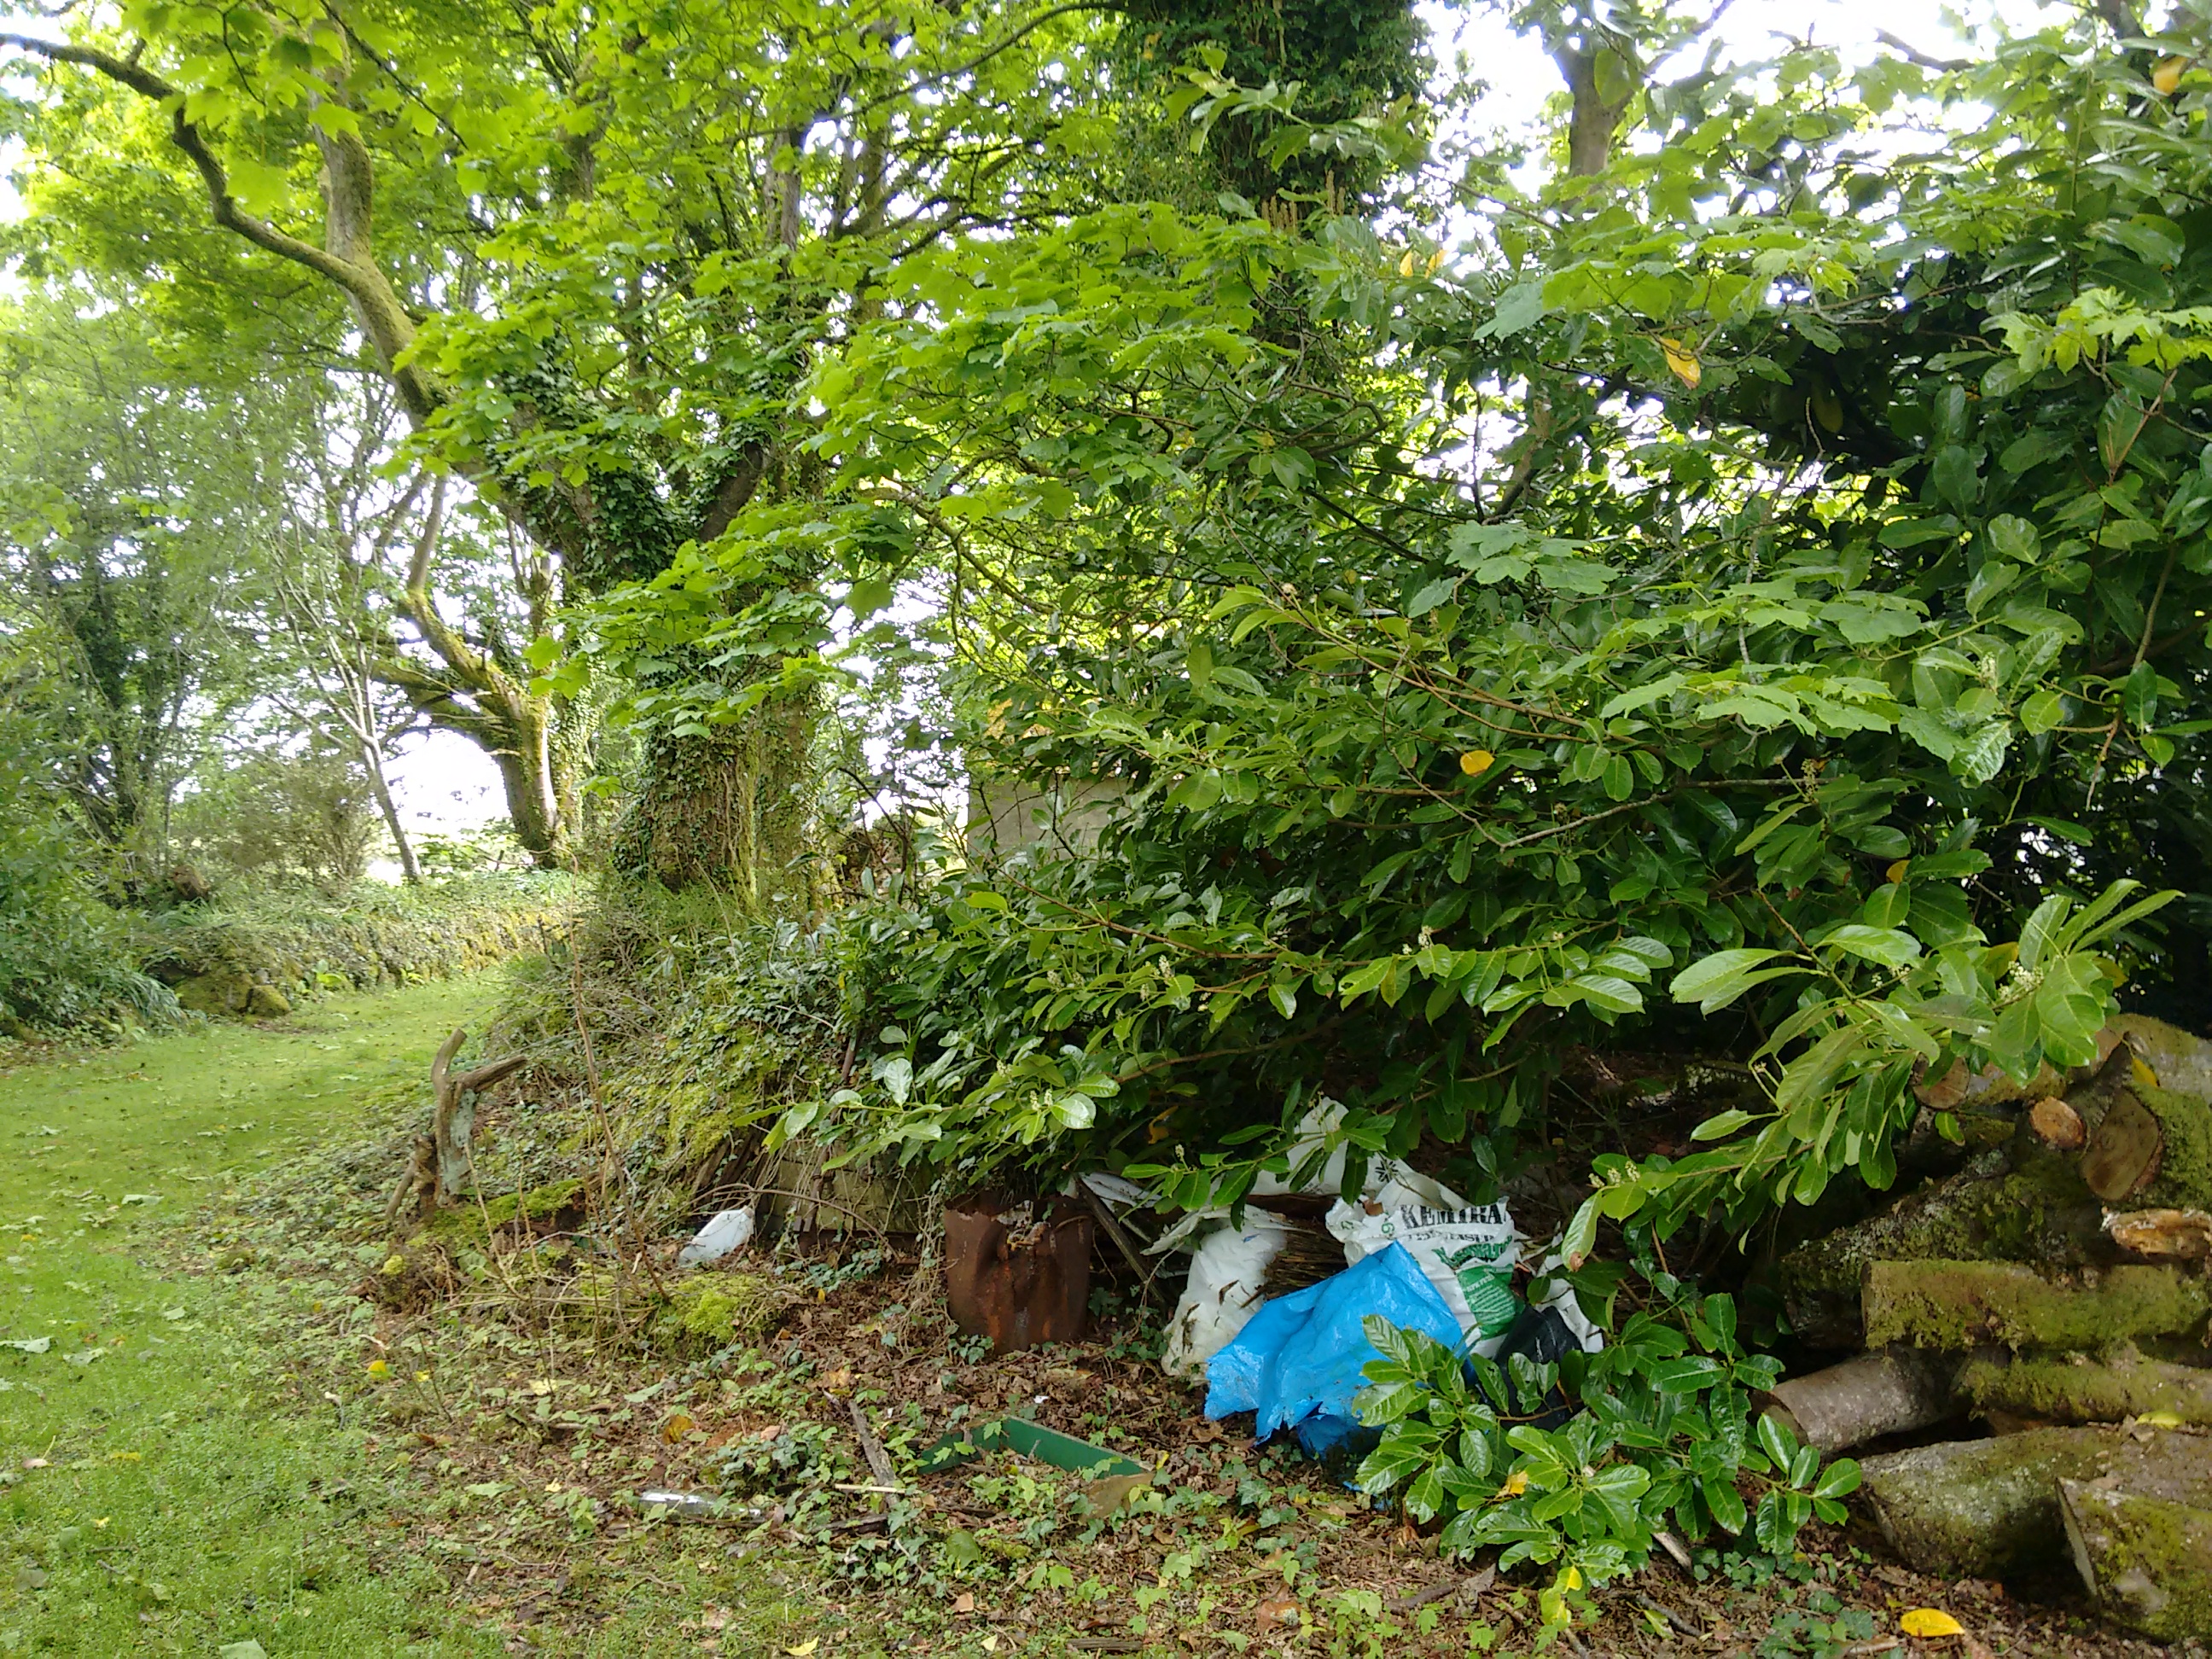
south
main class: Woodland
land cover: Broadleaved woodland
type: mesophytic deciduous forest
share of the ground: > 75 %
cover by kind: broadleaved forest trees 100 %
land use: Semi-natural and natural areas not in use
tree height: > 5 m
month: June
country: GB
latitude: 54.9894
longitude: -6.9692
